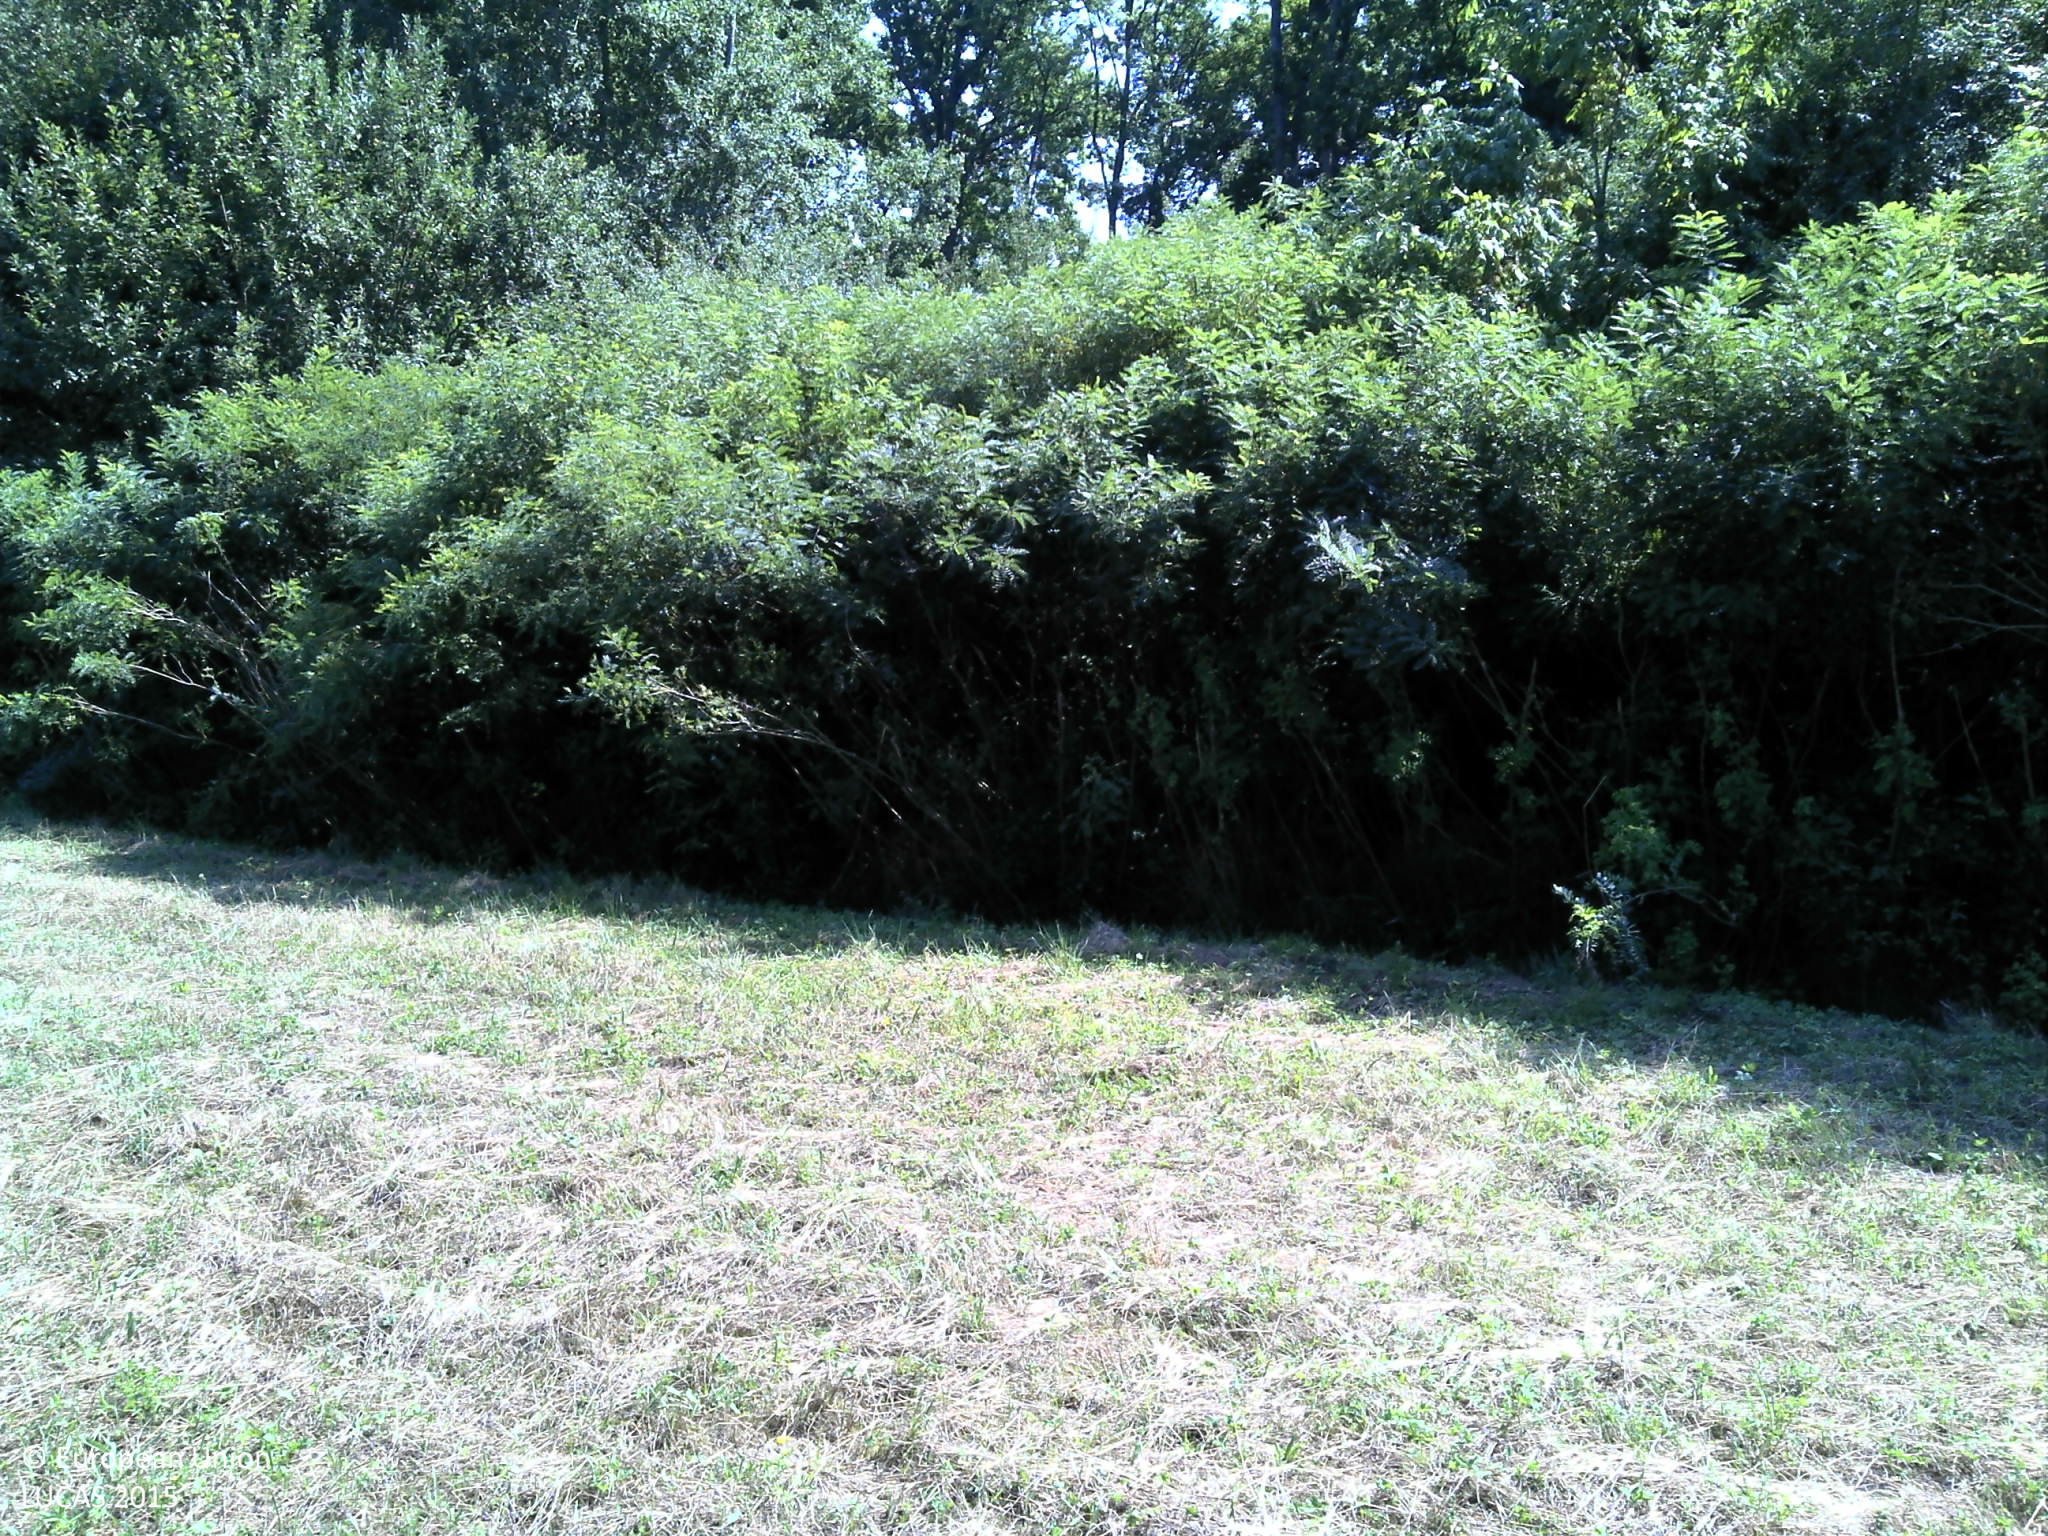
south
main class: Grassland
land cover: Grassland without tree/shrub cover
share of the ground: > 75 %
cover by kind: herbaceous plants 100 %
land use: Semi-natural and natural areas not in use
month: August
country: HR
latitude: 45.4810
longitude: 16.5613
